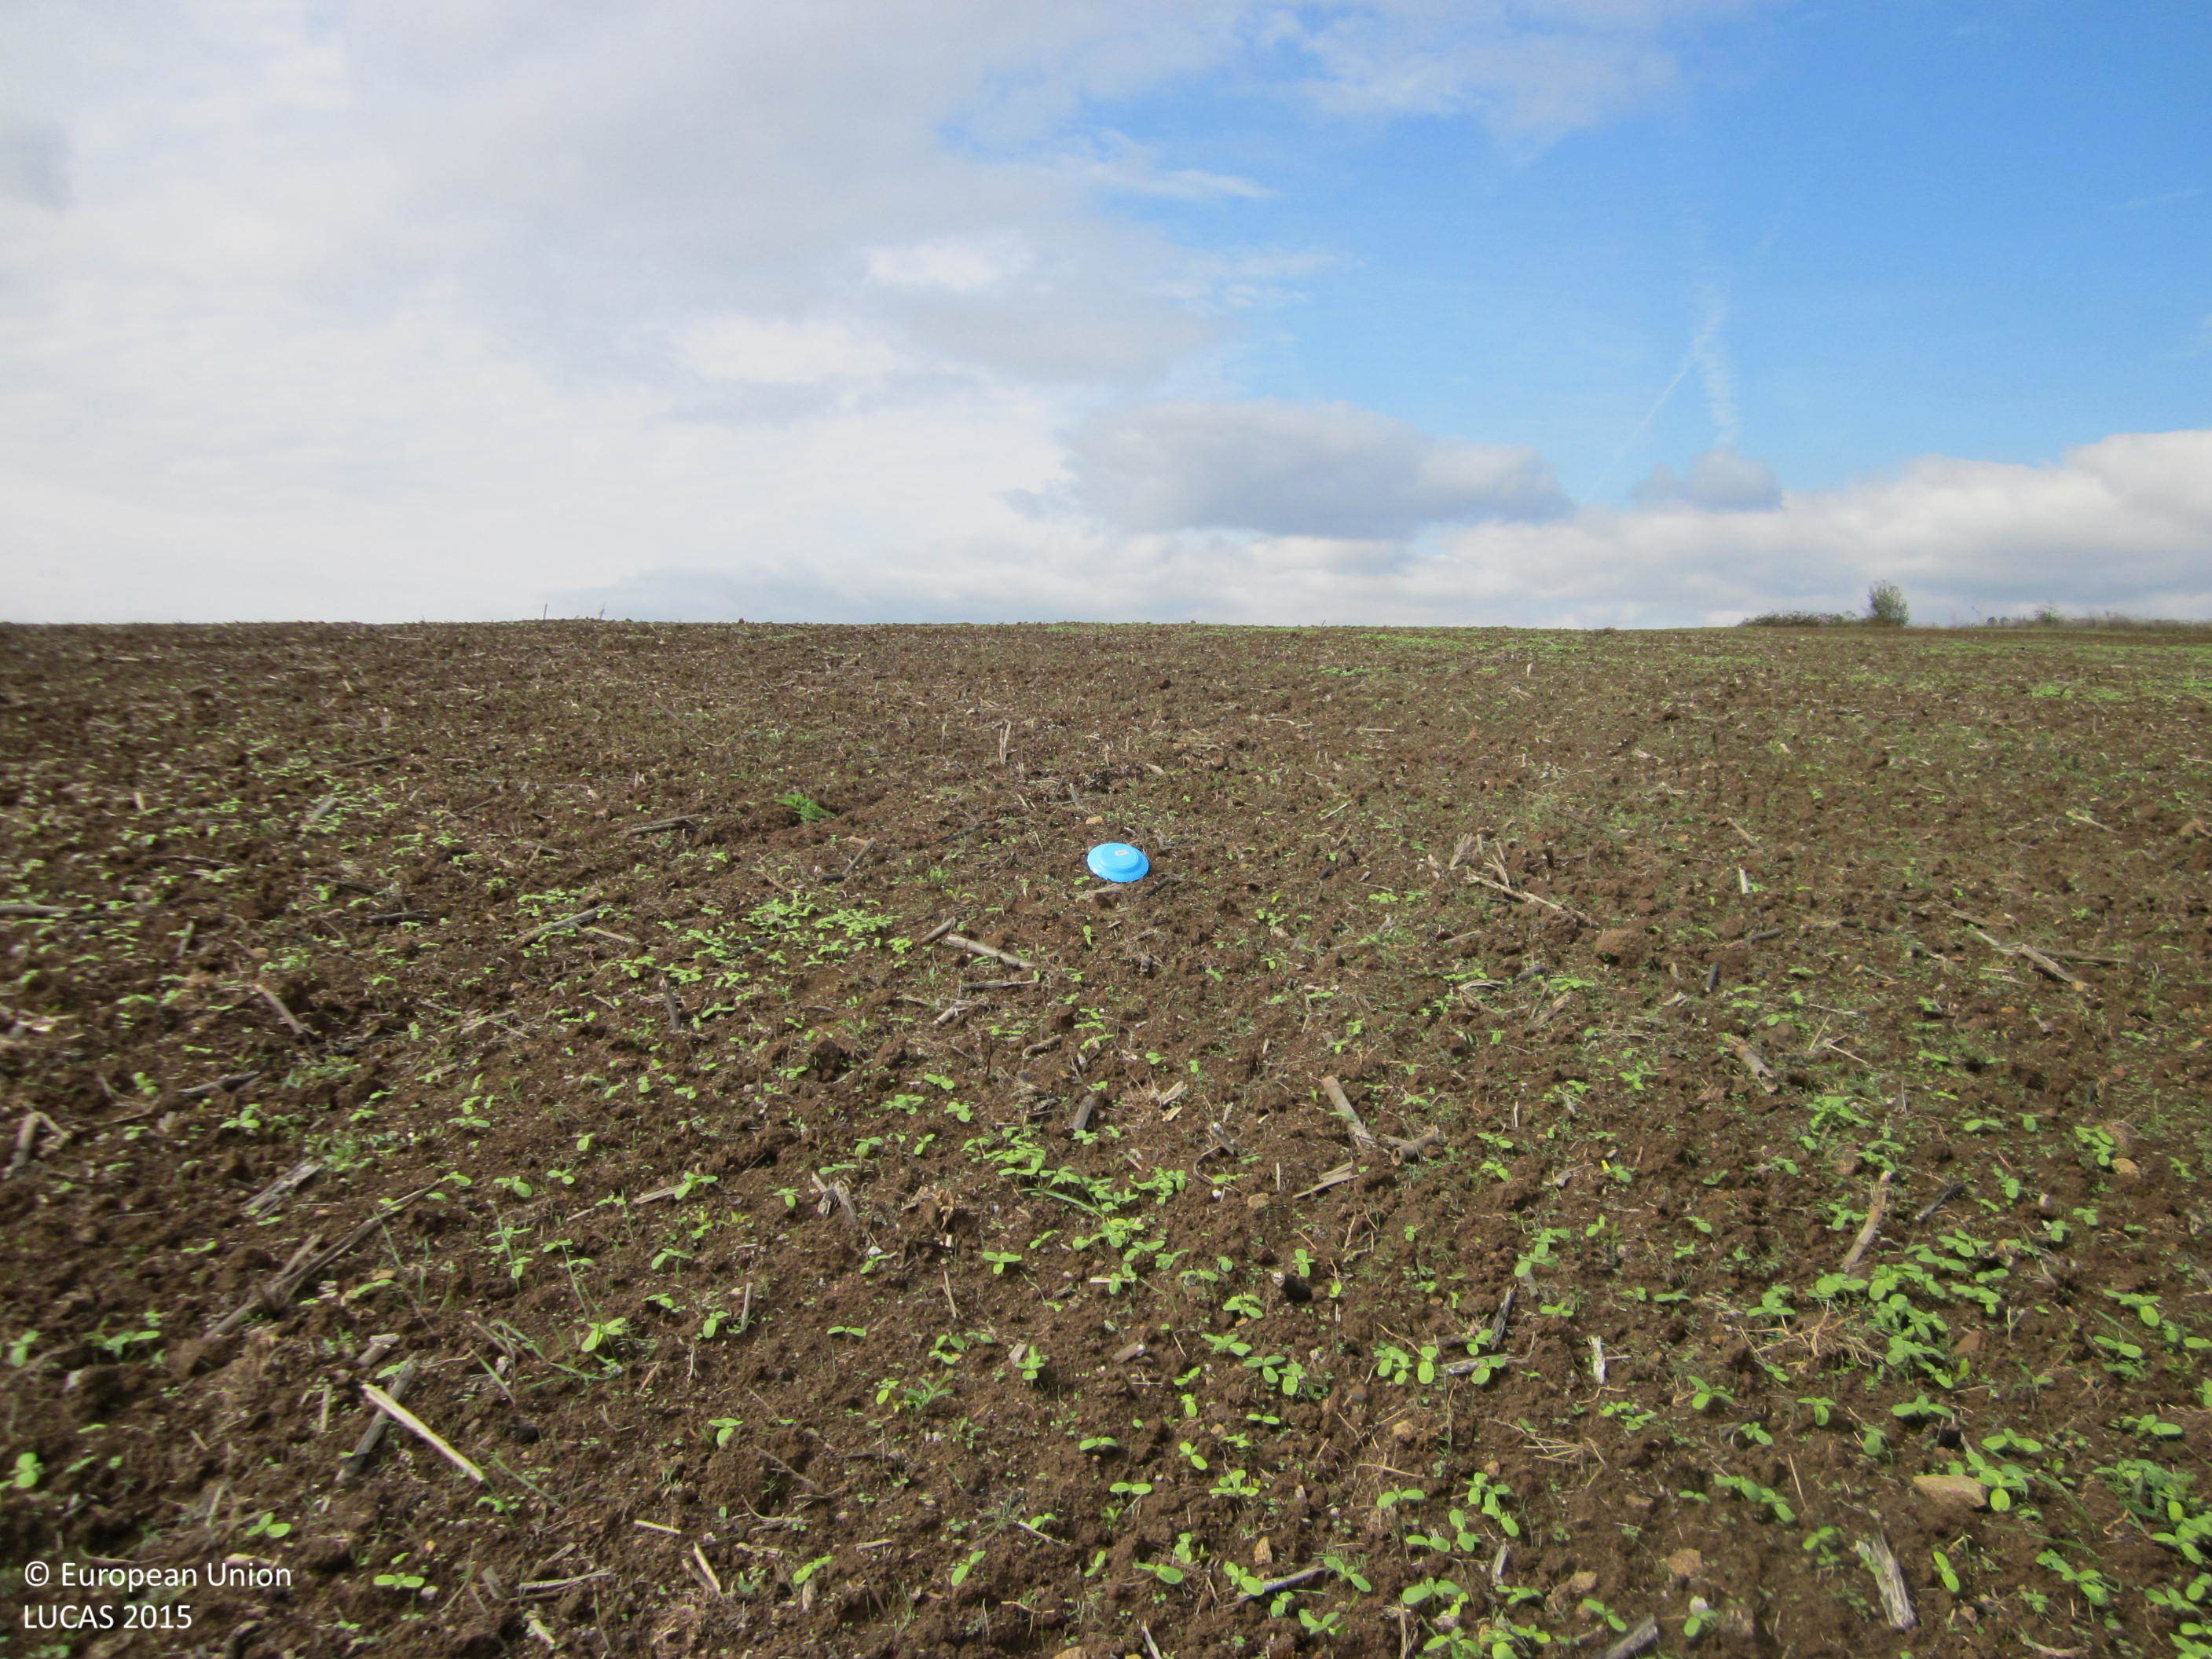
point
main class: Cropland
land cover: Sunflower
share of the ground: < 10 %
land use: Agriculture (excluding fallow land and kitchen gardens)
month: October
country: BG
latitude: 42.3658
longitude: 26.9930
